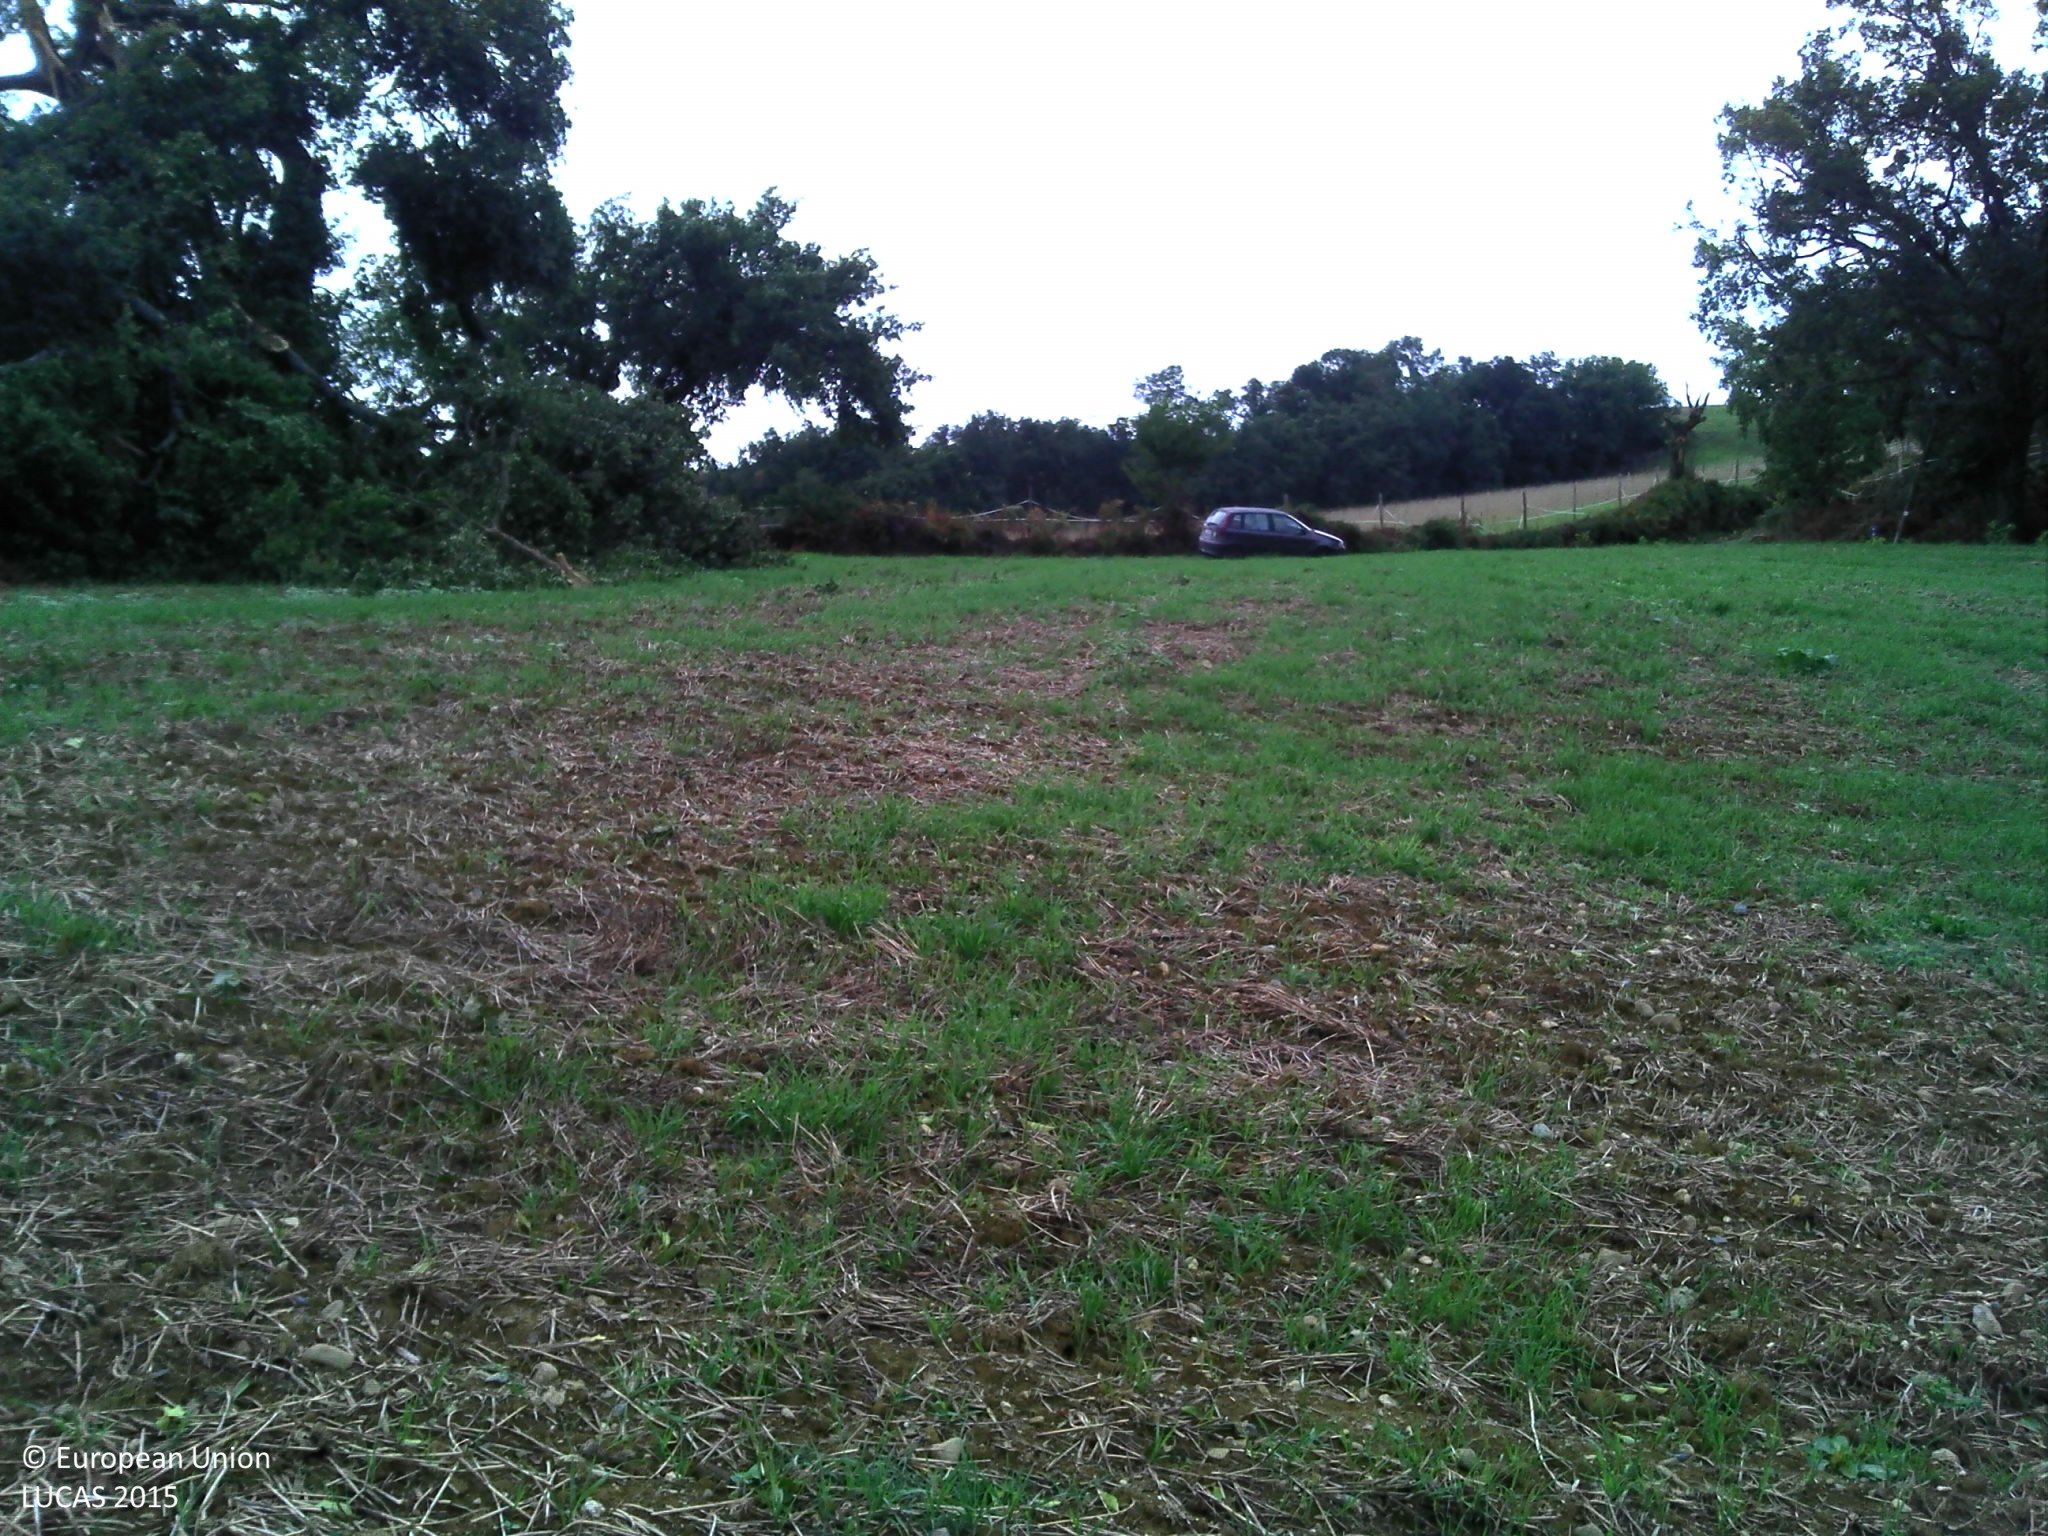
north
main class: Cropland
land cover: Common wheat
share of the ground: > 75 %
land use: Agriculture (excluding fallow land and kitchen gardens)
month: September
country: FR
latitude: 43.4424
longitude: -0.4241
